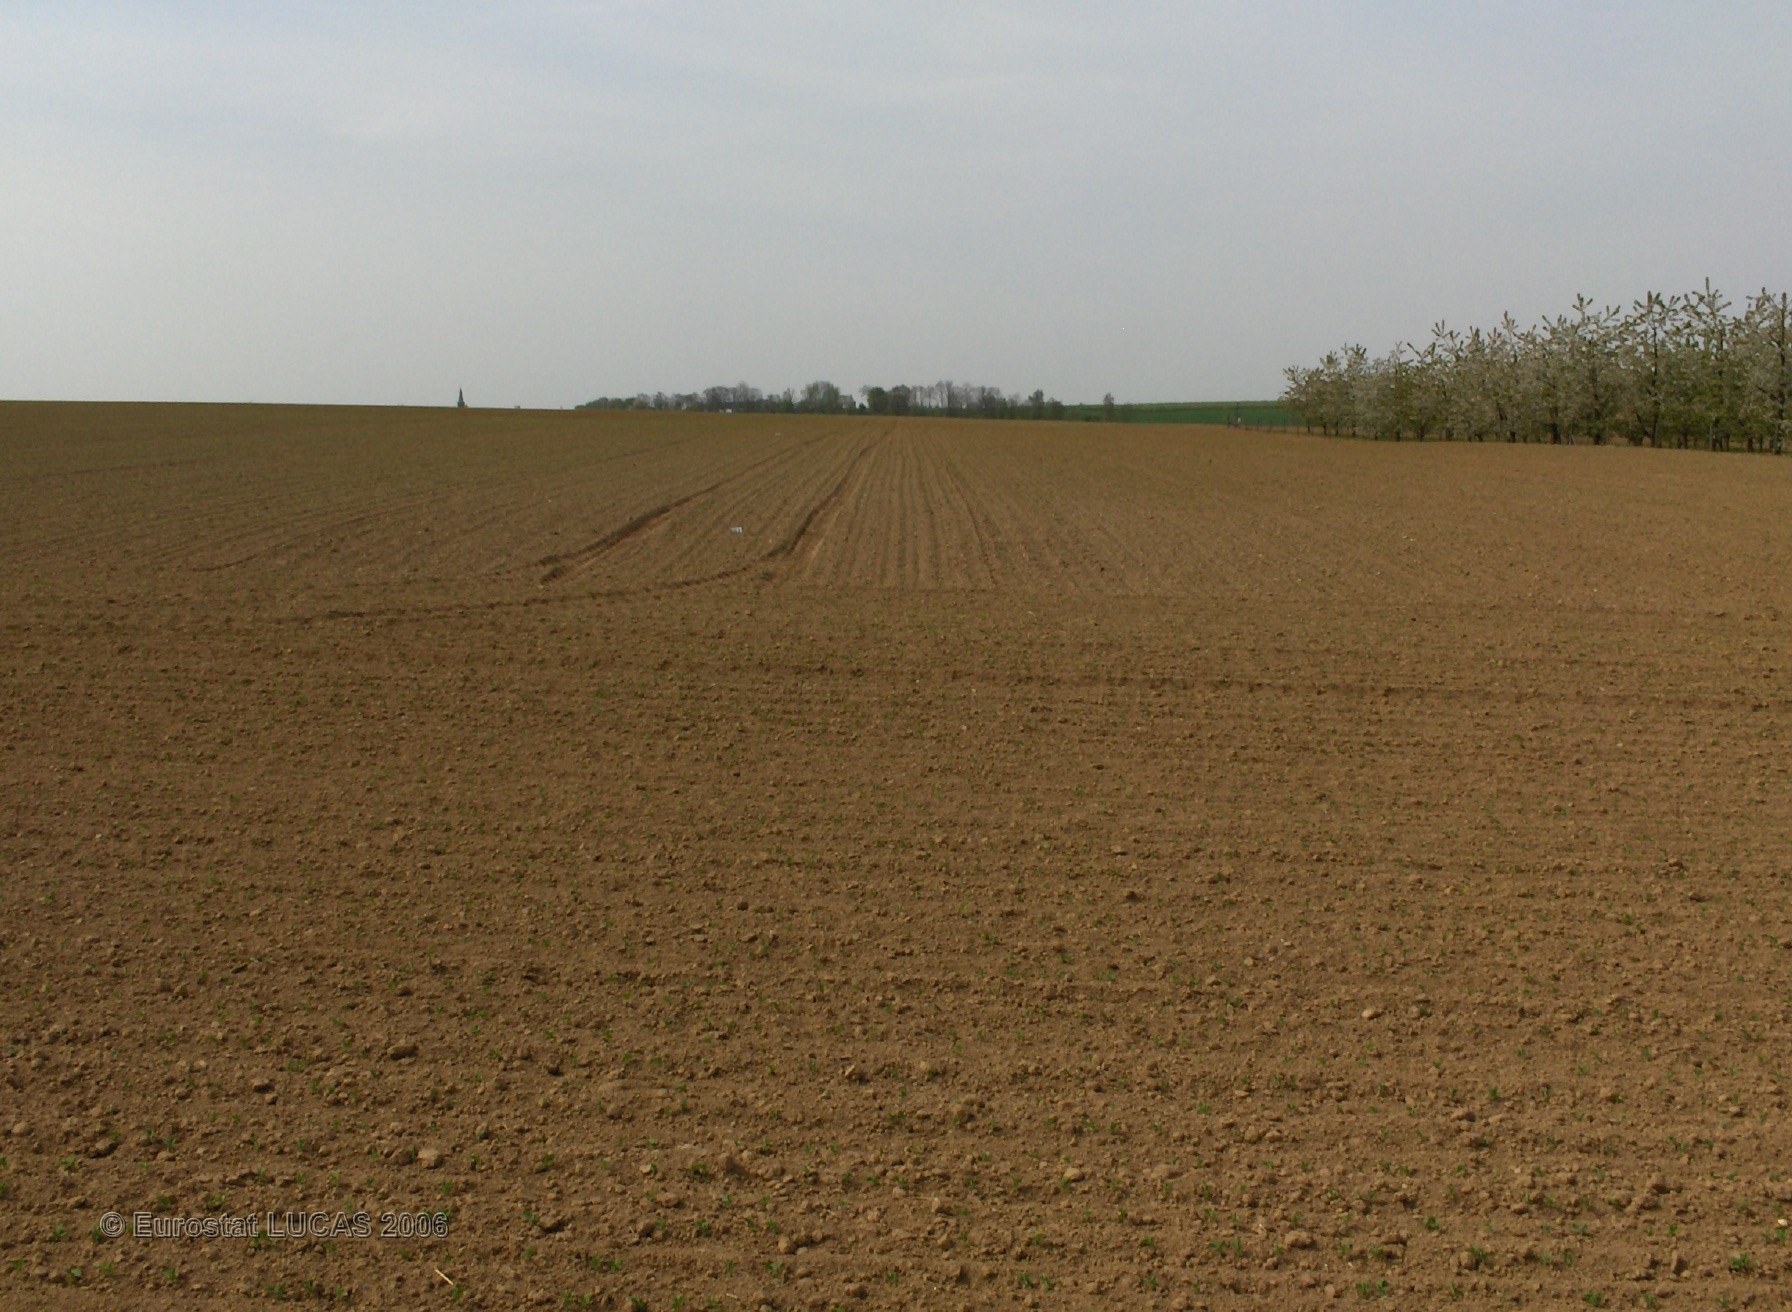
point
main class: Cropland
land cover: Dry pulses
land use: Agriculture (excluding fallow land and kitchen gardens)
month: May
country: BE
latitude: 50.7506
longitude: 5.2211
